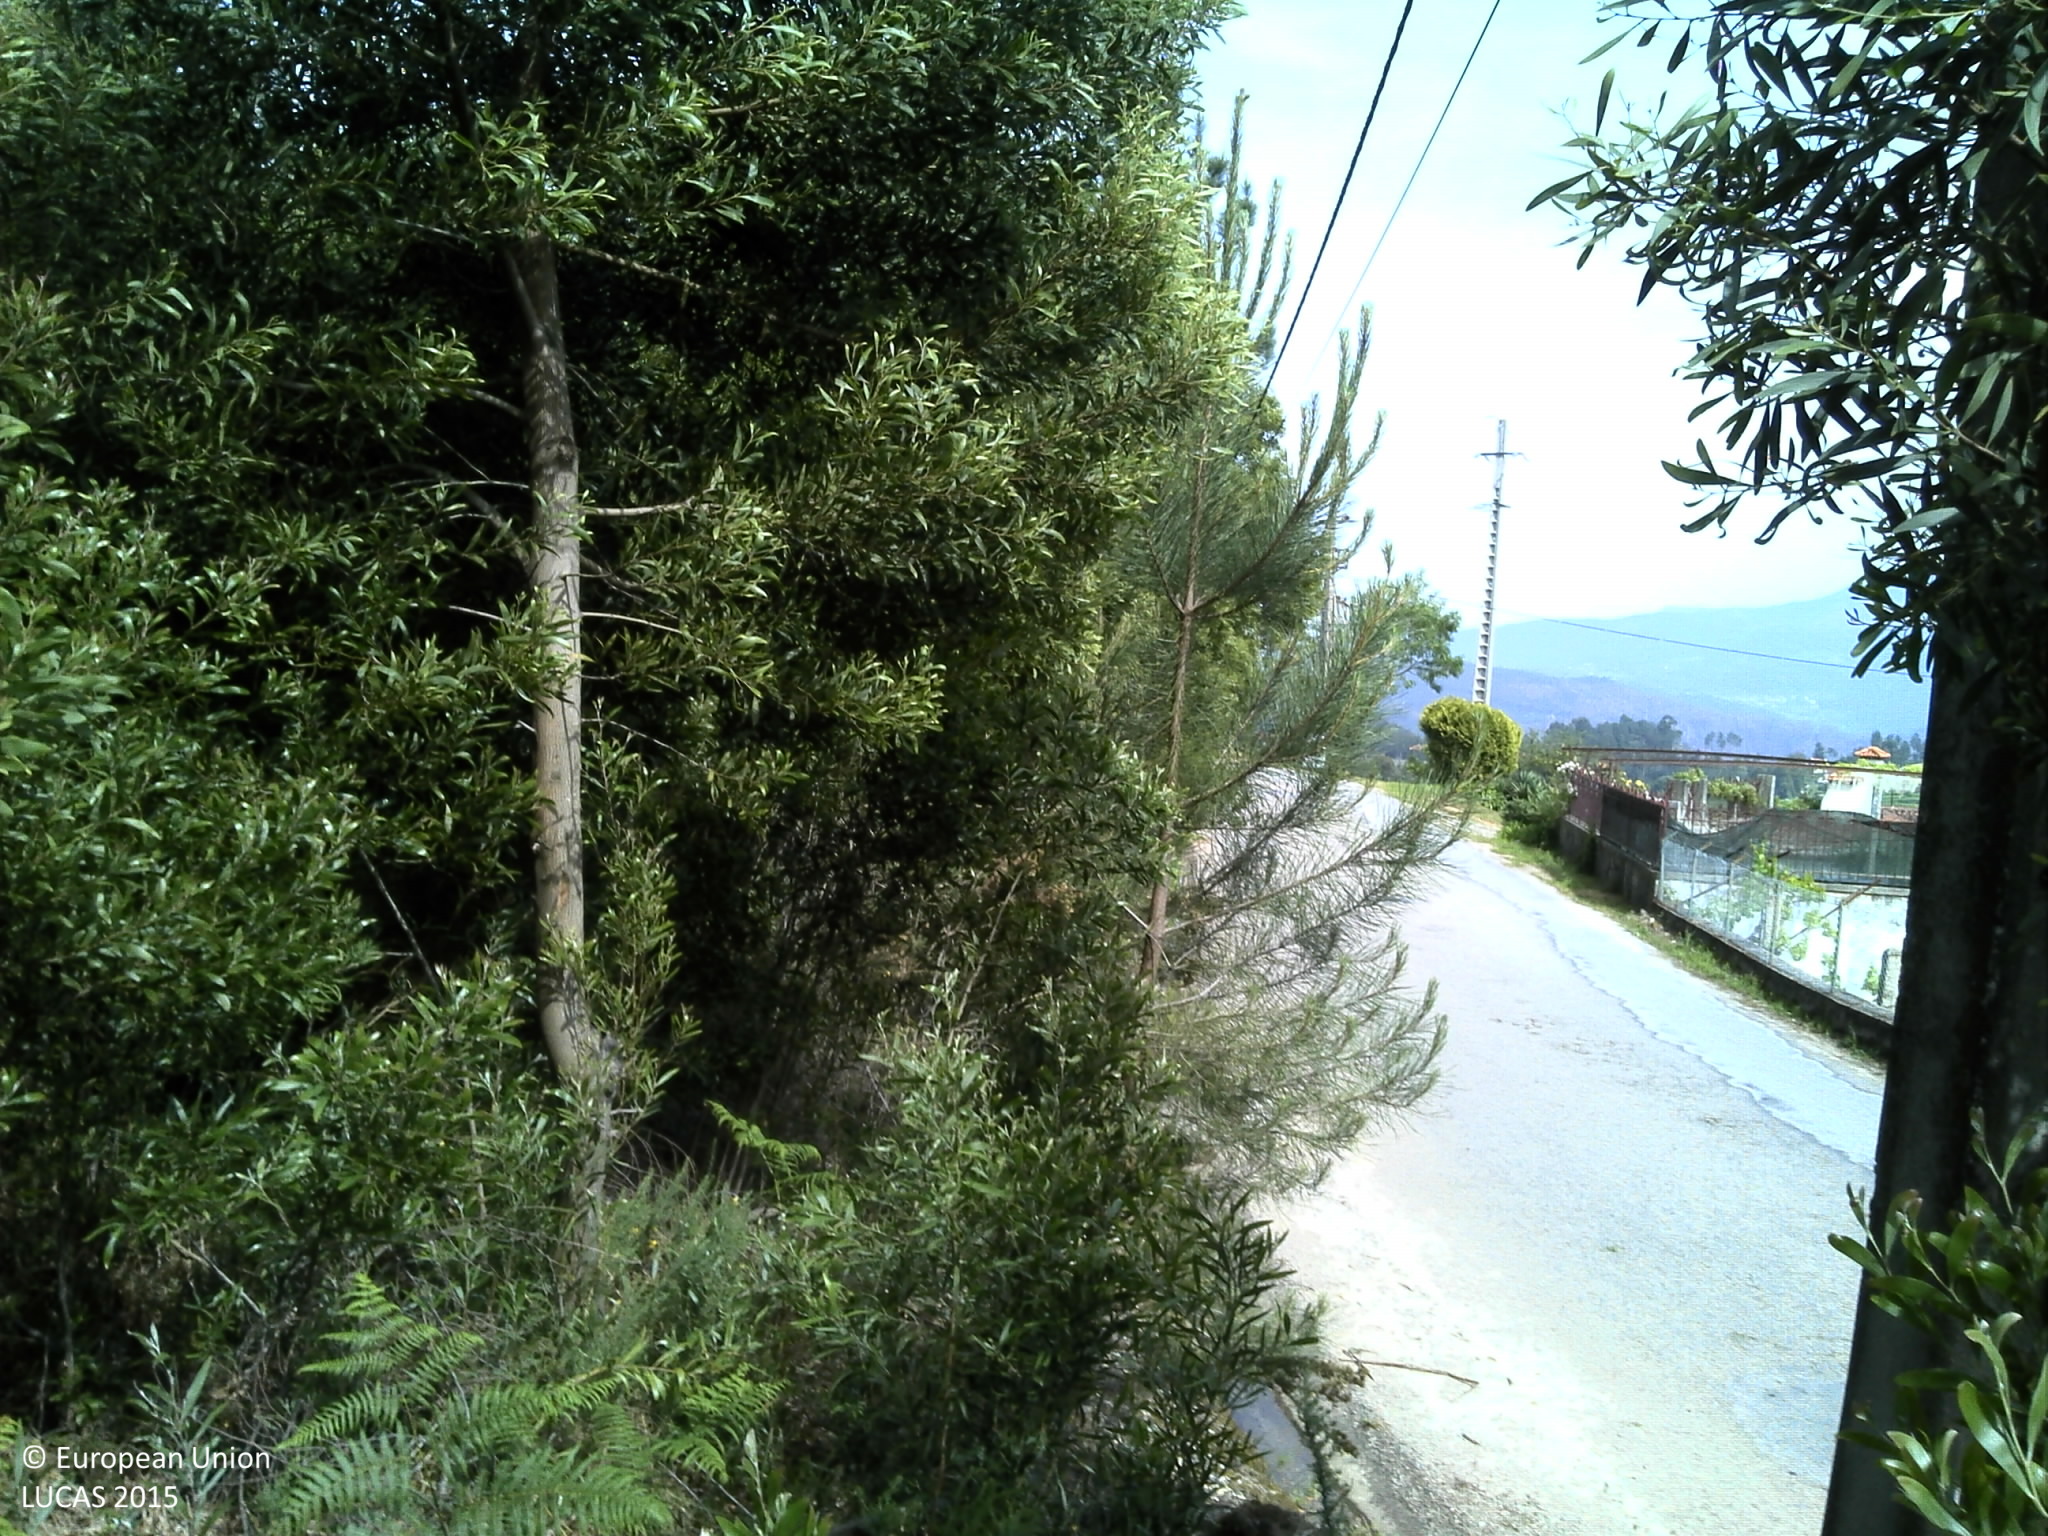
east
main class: Woodland
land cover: Pine dominated coniferous woodland
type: coniferous forest of the mediterranean region
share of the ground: 50 - 75 %
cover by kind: coniferous forest trees 75 %, shrubs 20 %, unconsolidated bare surface 5 %
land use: Forestry
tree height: > 5 m
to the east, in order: Pine dominated coniferous woodland; Artificial constructions in urban areas; Spontaneously vegetated surfaces; Dry stone walls; Vineyards; Tracks; Vineyards; Dry stone walls; Other leguminous and mixtures for fodder; Vineyards; Spontaneously vegetated surfaces; Artificial constructions in urban areas
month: May
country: PT
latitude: 40.9375
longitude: -8.3736
